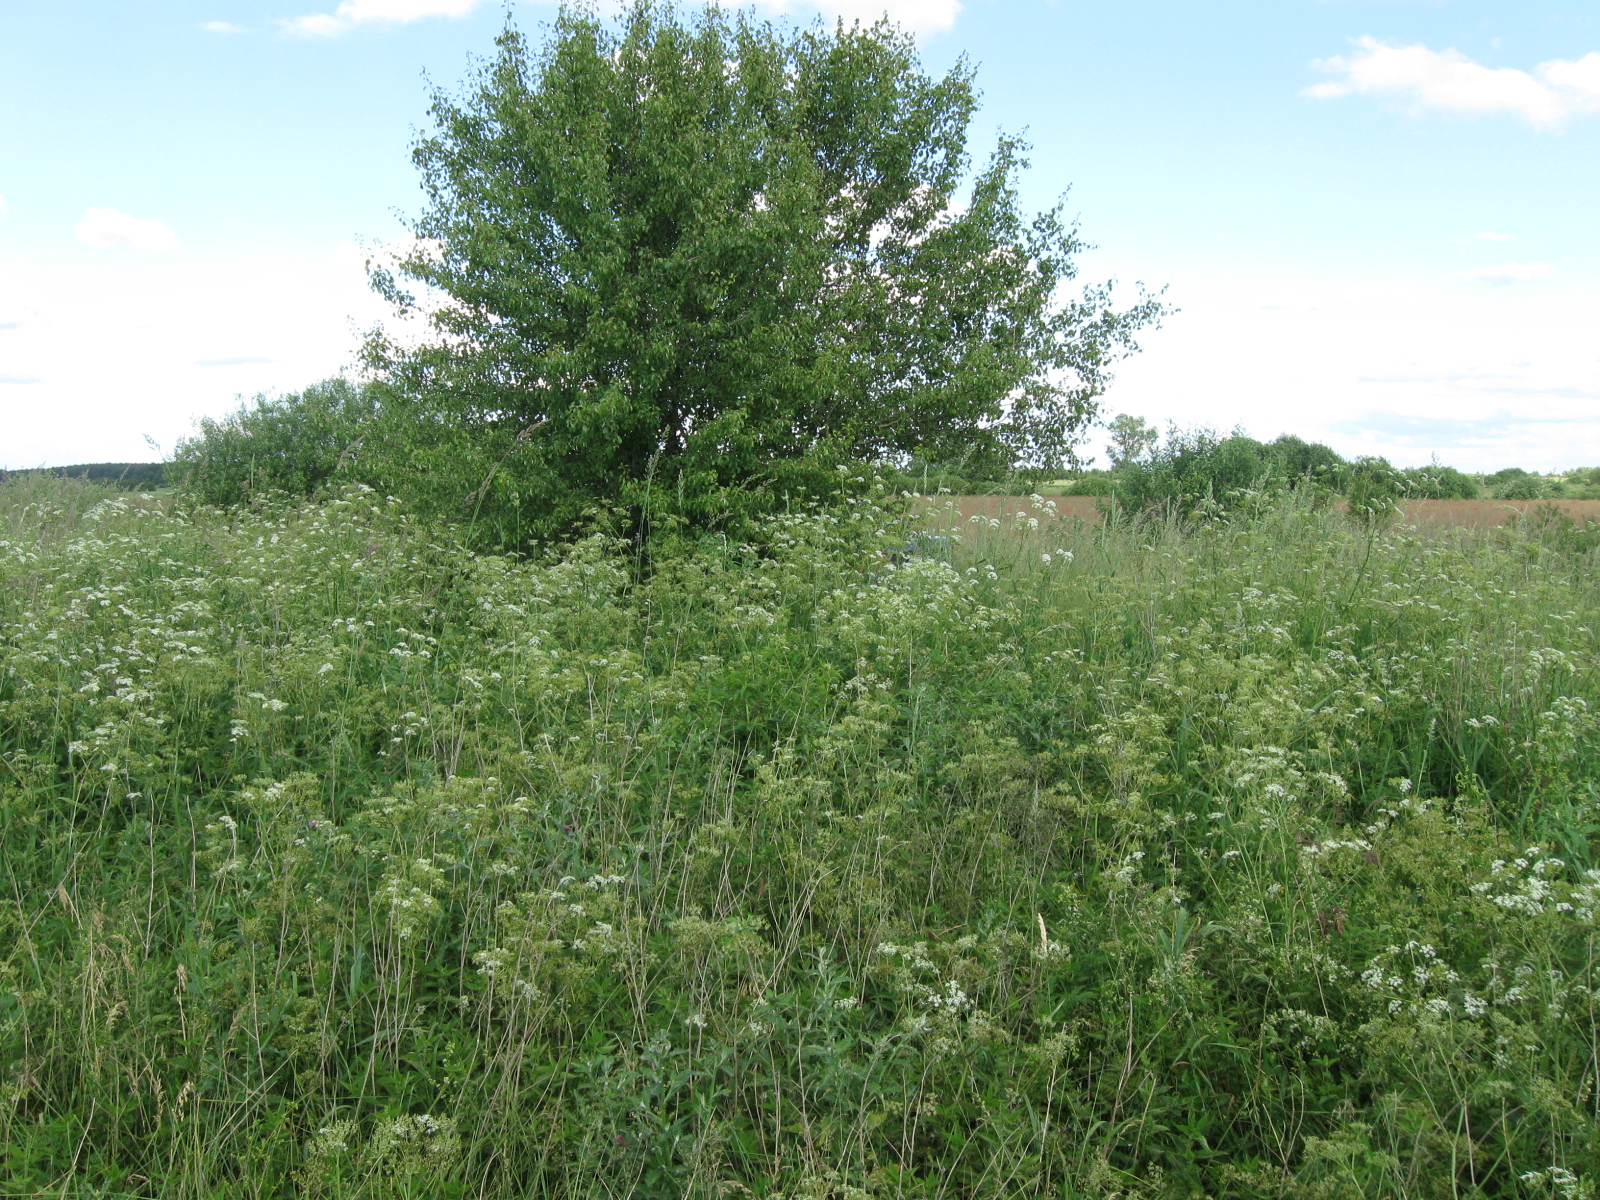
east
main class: Grassland
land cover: Spontaneously vegetated surfaces
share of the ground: > 75 %
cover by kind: herbaceous plants 100 %
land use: Fallow land
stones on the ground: < 10 %
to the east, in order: Spontaneously vegetated surfaces; Single bushes/trees; Paved roads, cycling and walking lanes; Spontaneously vegetated surfaces; Ditches and canals; Shrubland with sparse tree cover; Spontaneously vegetated surfaces; Broadleaved woodland; Ditches and canals; Broadleaved woodland; Spontaneously vegetated surfaces
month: June
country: LT
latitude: 54.4540
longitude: 24.7147
